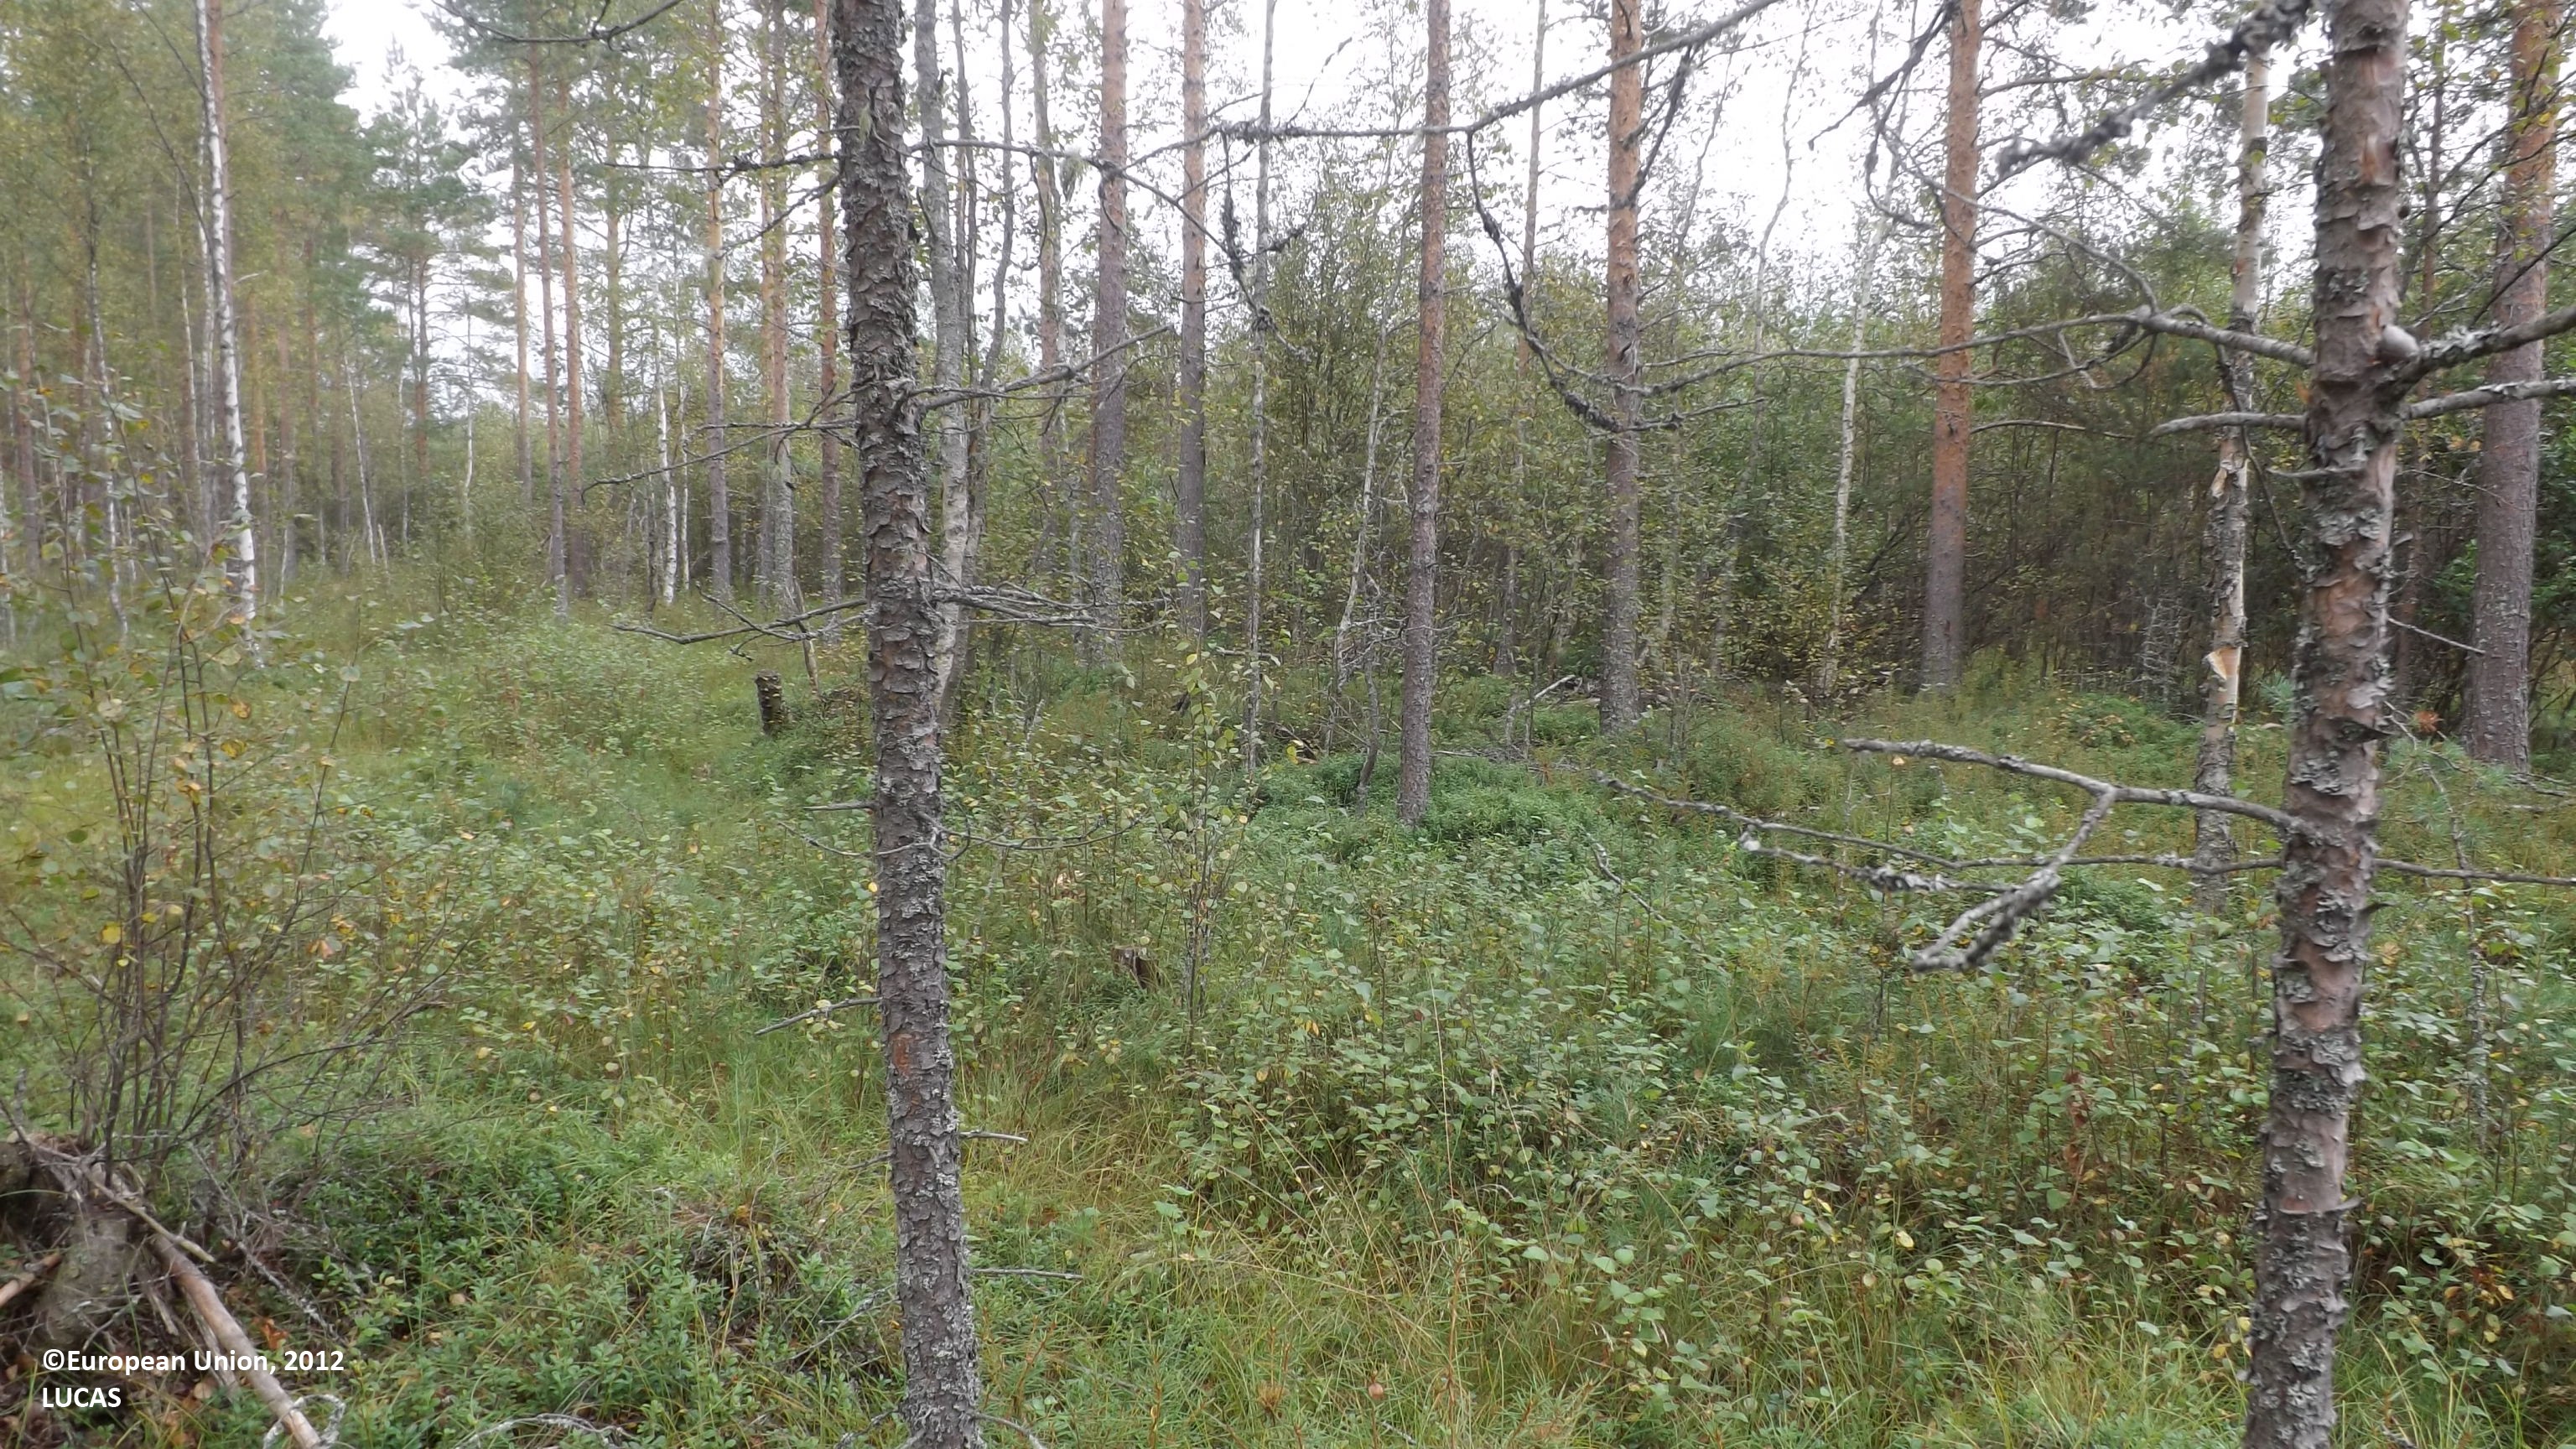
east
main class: Woodland
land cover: Pine dominated mixed woodland
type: boreal forest
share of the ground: 50 - 75 %
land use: Forestry
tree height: > 5 m
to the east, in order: Pine dominated mixed woodland; Ditches and canals; Broadleaved woodland; Ditches and canals; Broadleaved woodland; Ditches and canals; Broadleaved woodland; Ditches and canals; Broadleaved woodland; Ditches and canals; Broadleaved woodland; Ditches and canals; Broadleaved woodland; Ditches and canals; Pine dominated mixed woodland; Pine dominated coniferous woodland; Ditches and canals; Pine dominated mixed woodland; Pine dominated coniferous woodland
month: August
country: FI
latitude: 63.9005
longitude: 23.8153
